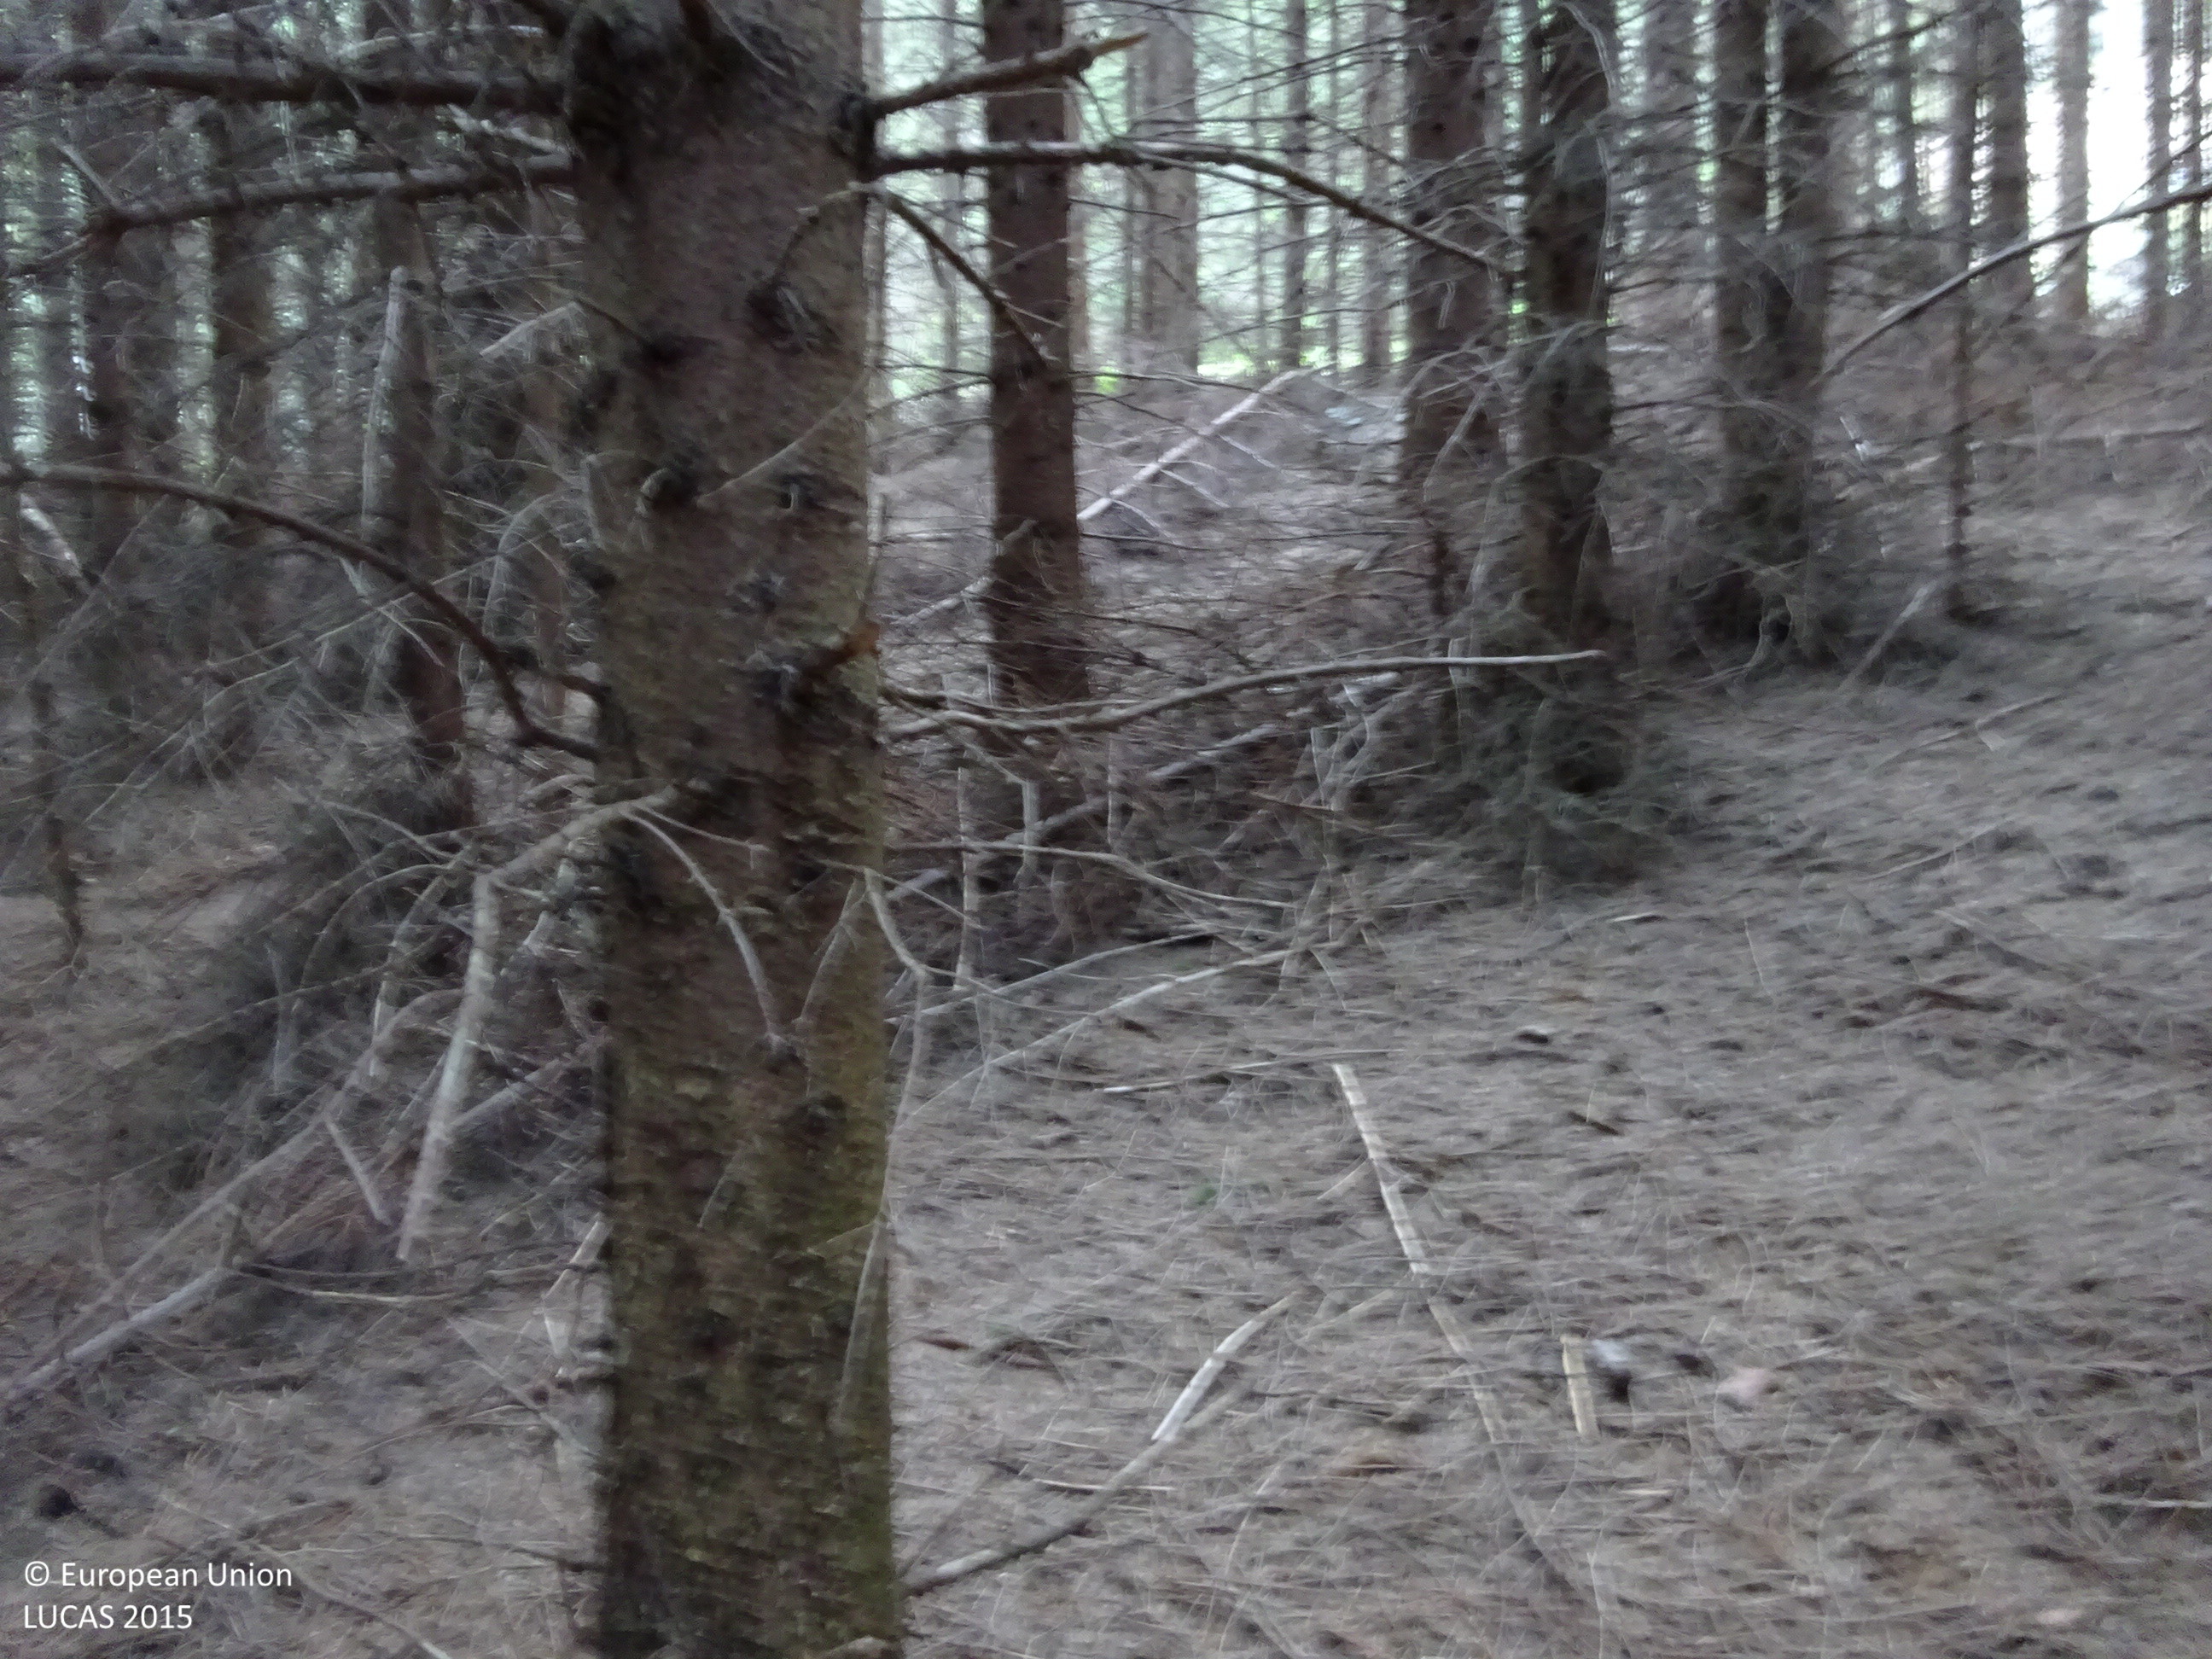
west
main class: Woodland
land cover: Spruce dominated coniferous woodland
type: alpine coniferous forest
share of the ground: > 75 %
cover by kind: coniferous forest trees 100 %
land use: Forestry
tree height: > 5 m
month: August
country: AT
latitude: 47.5551
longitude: 15.9957
